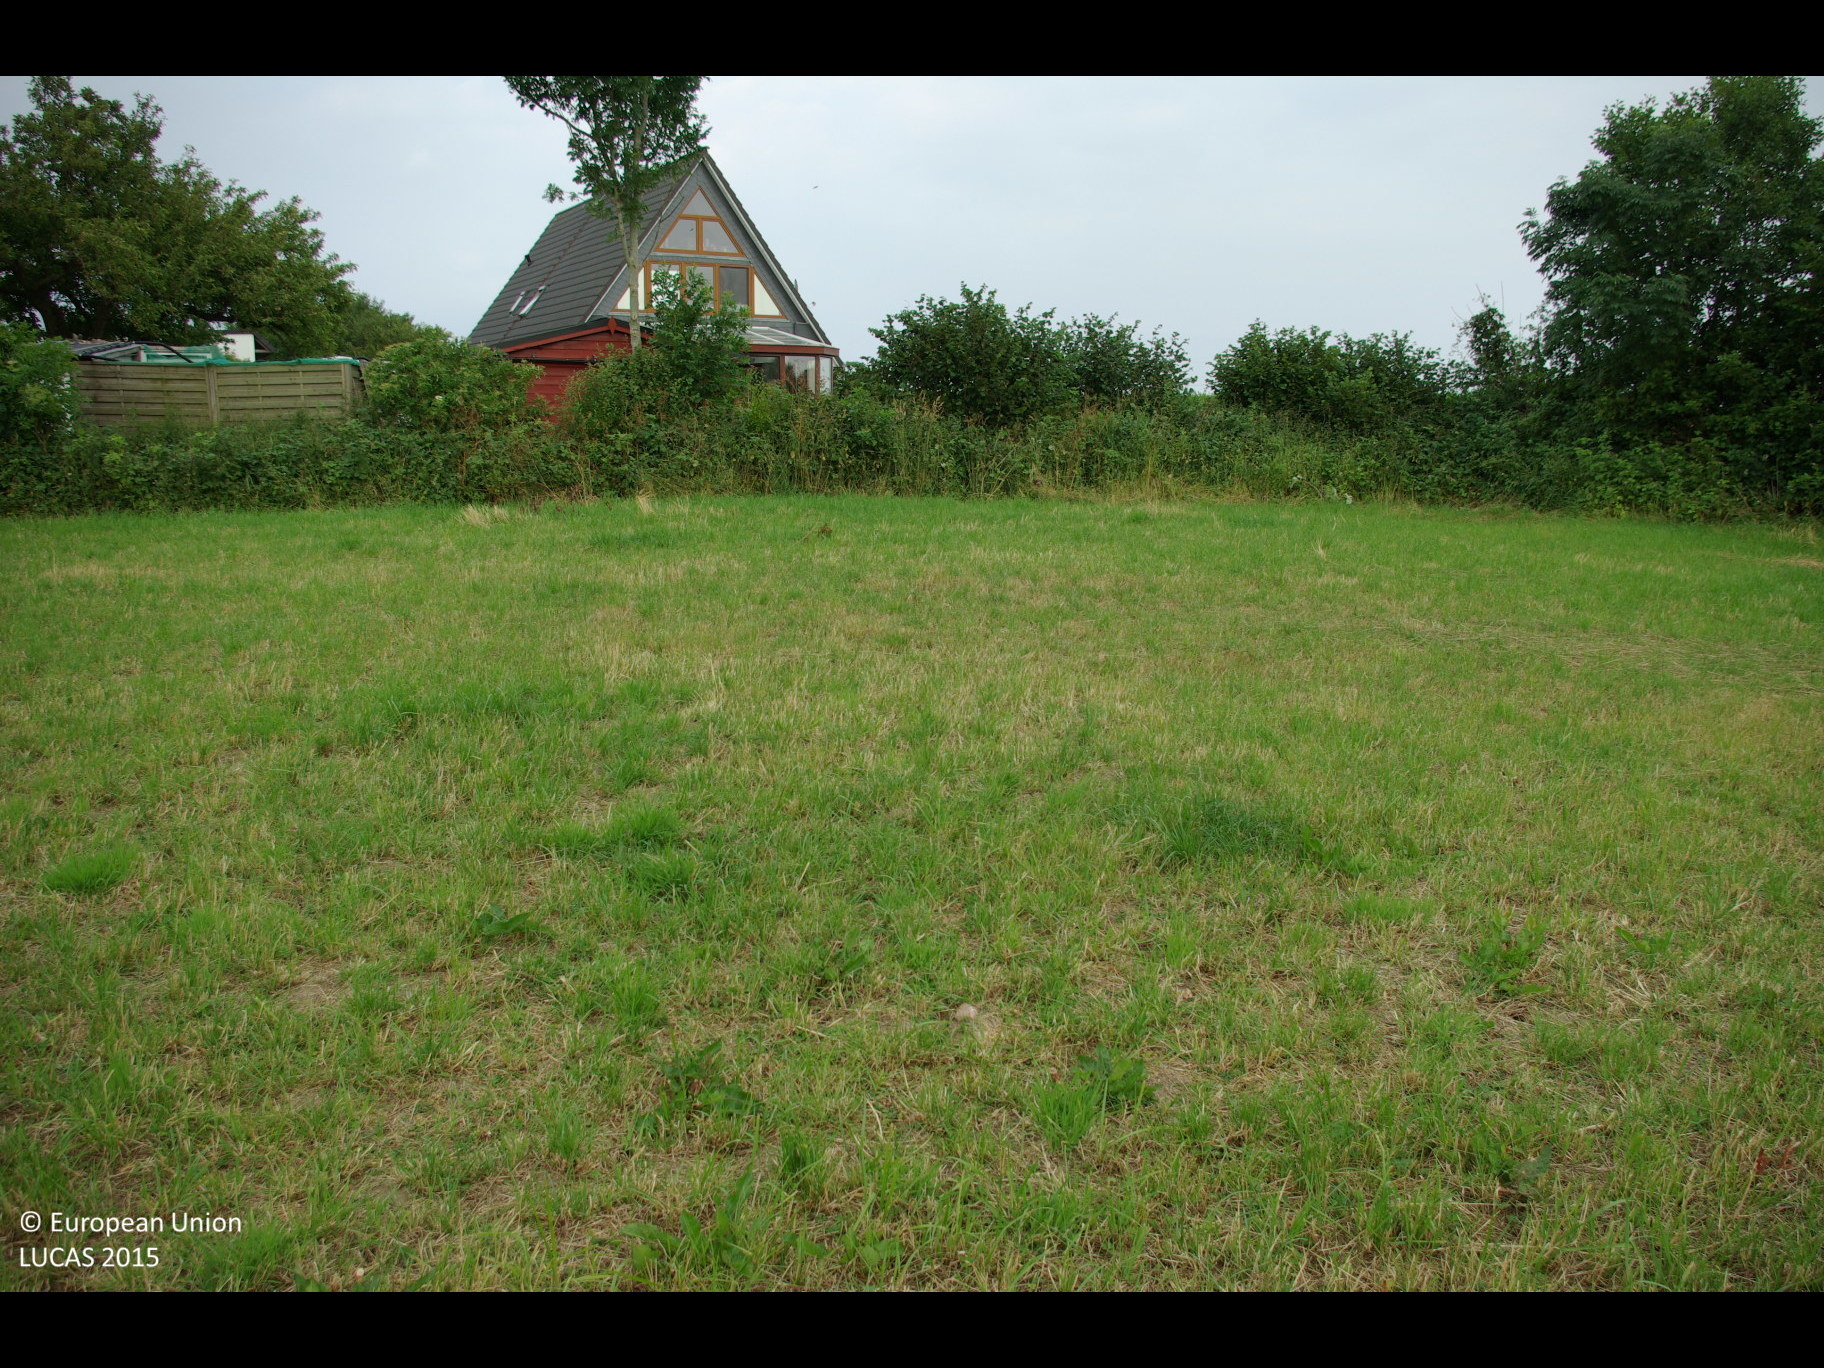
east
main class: Cropland
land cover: Temporary grasslands
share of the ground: > 75 %
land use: Agriculture (excluding fallow land and kitchen gardens)
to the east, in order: Temporary grasslands; Shrubland without tree cover; Grassland without tree/shrub cover; Artificial constructions in urban areas; Managed hedges; Paved roads, cycling and walking lanes; Shruby margins; Barley
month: July
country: DE
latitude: 54.6420
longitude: 9.9535
